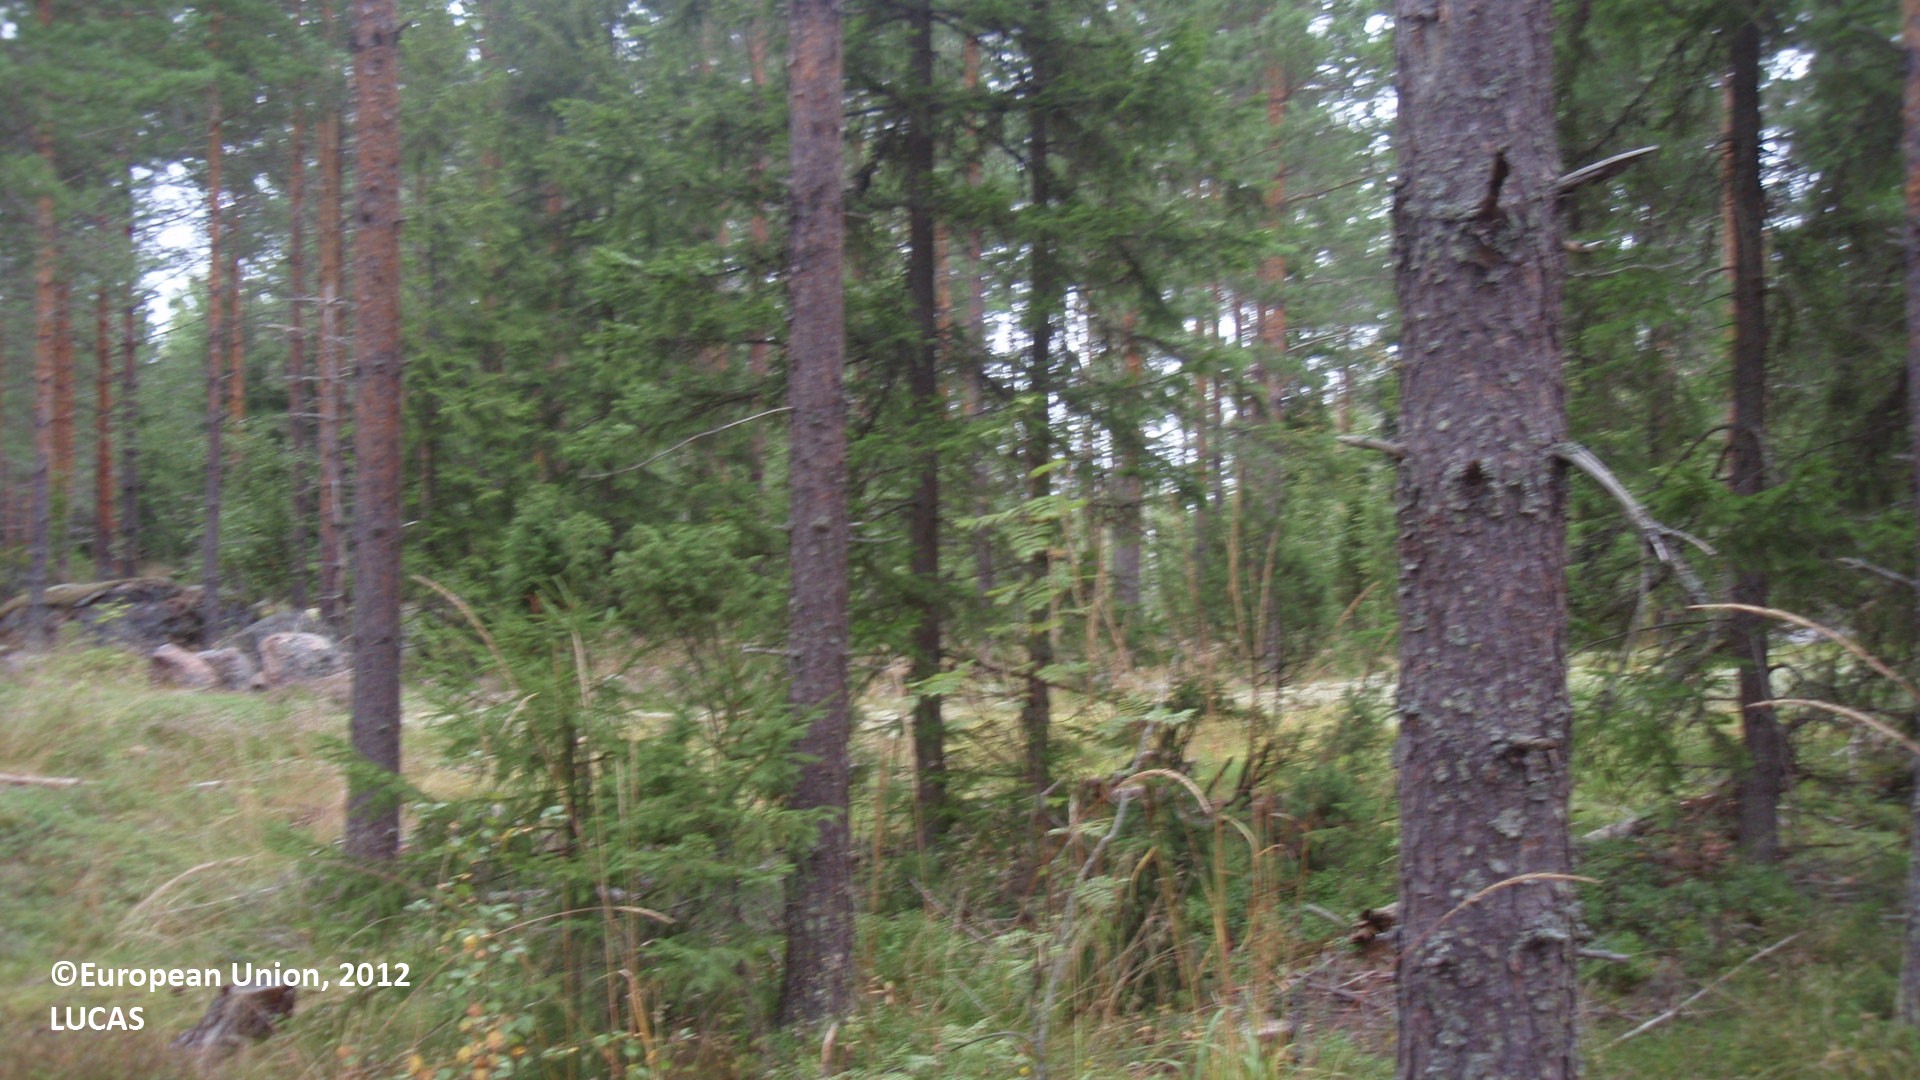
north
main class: Woodland
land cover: Other coniferous woodland
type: boreal forest
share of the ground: 50 - 75 %
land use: Forestry
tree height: > 5 m
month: August
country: FI
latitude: 60.5809
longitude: 26.8281
